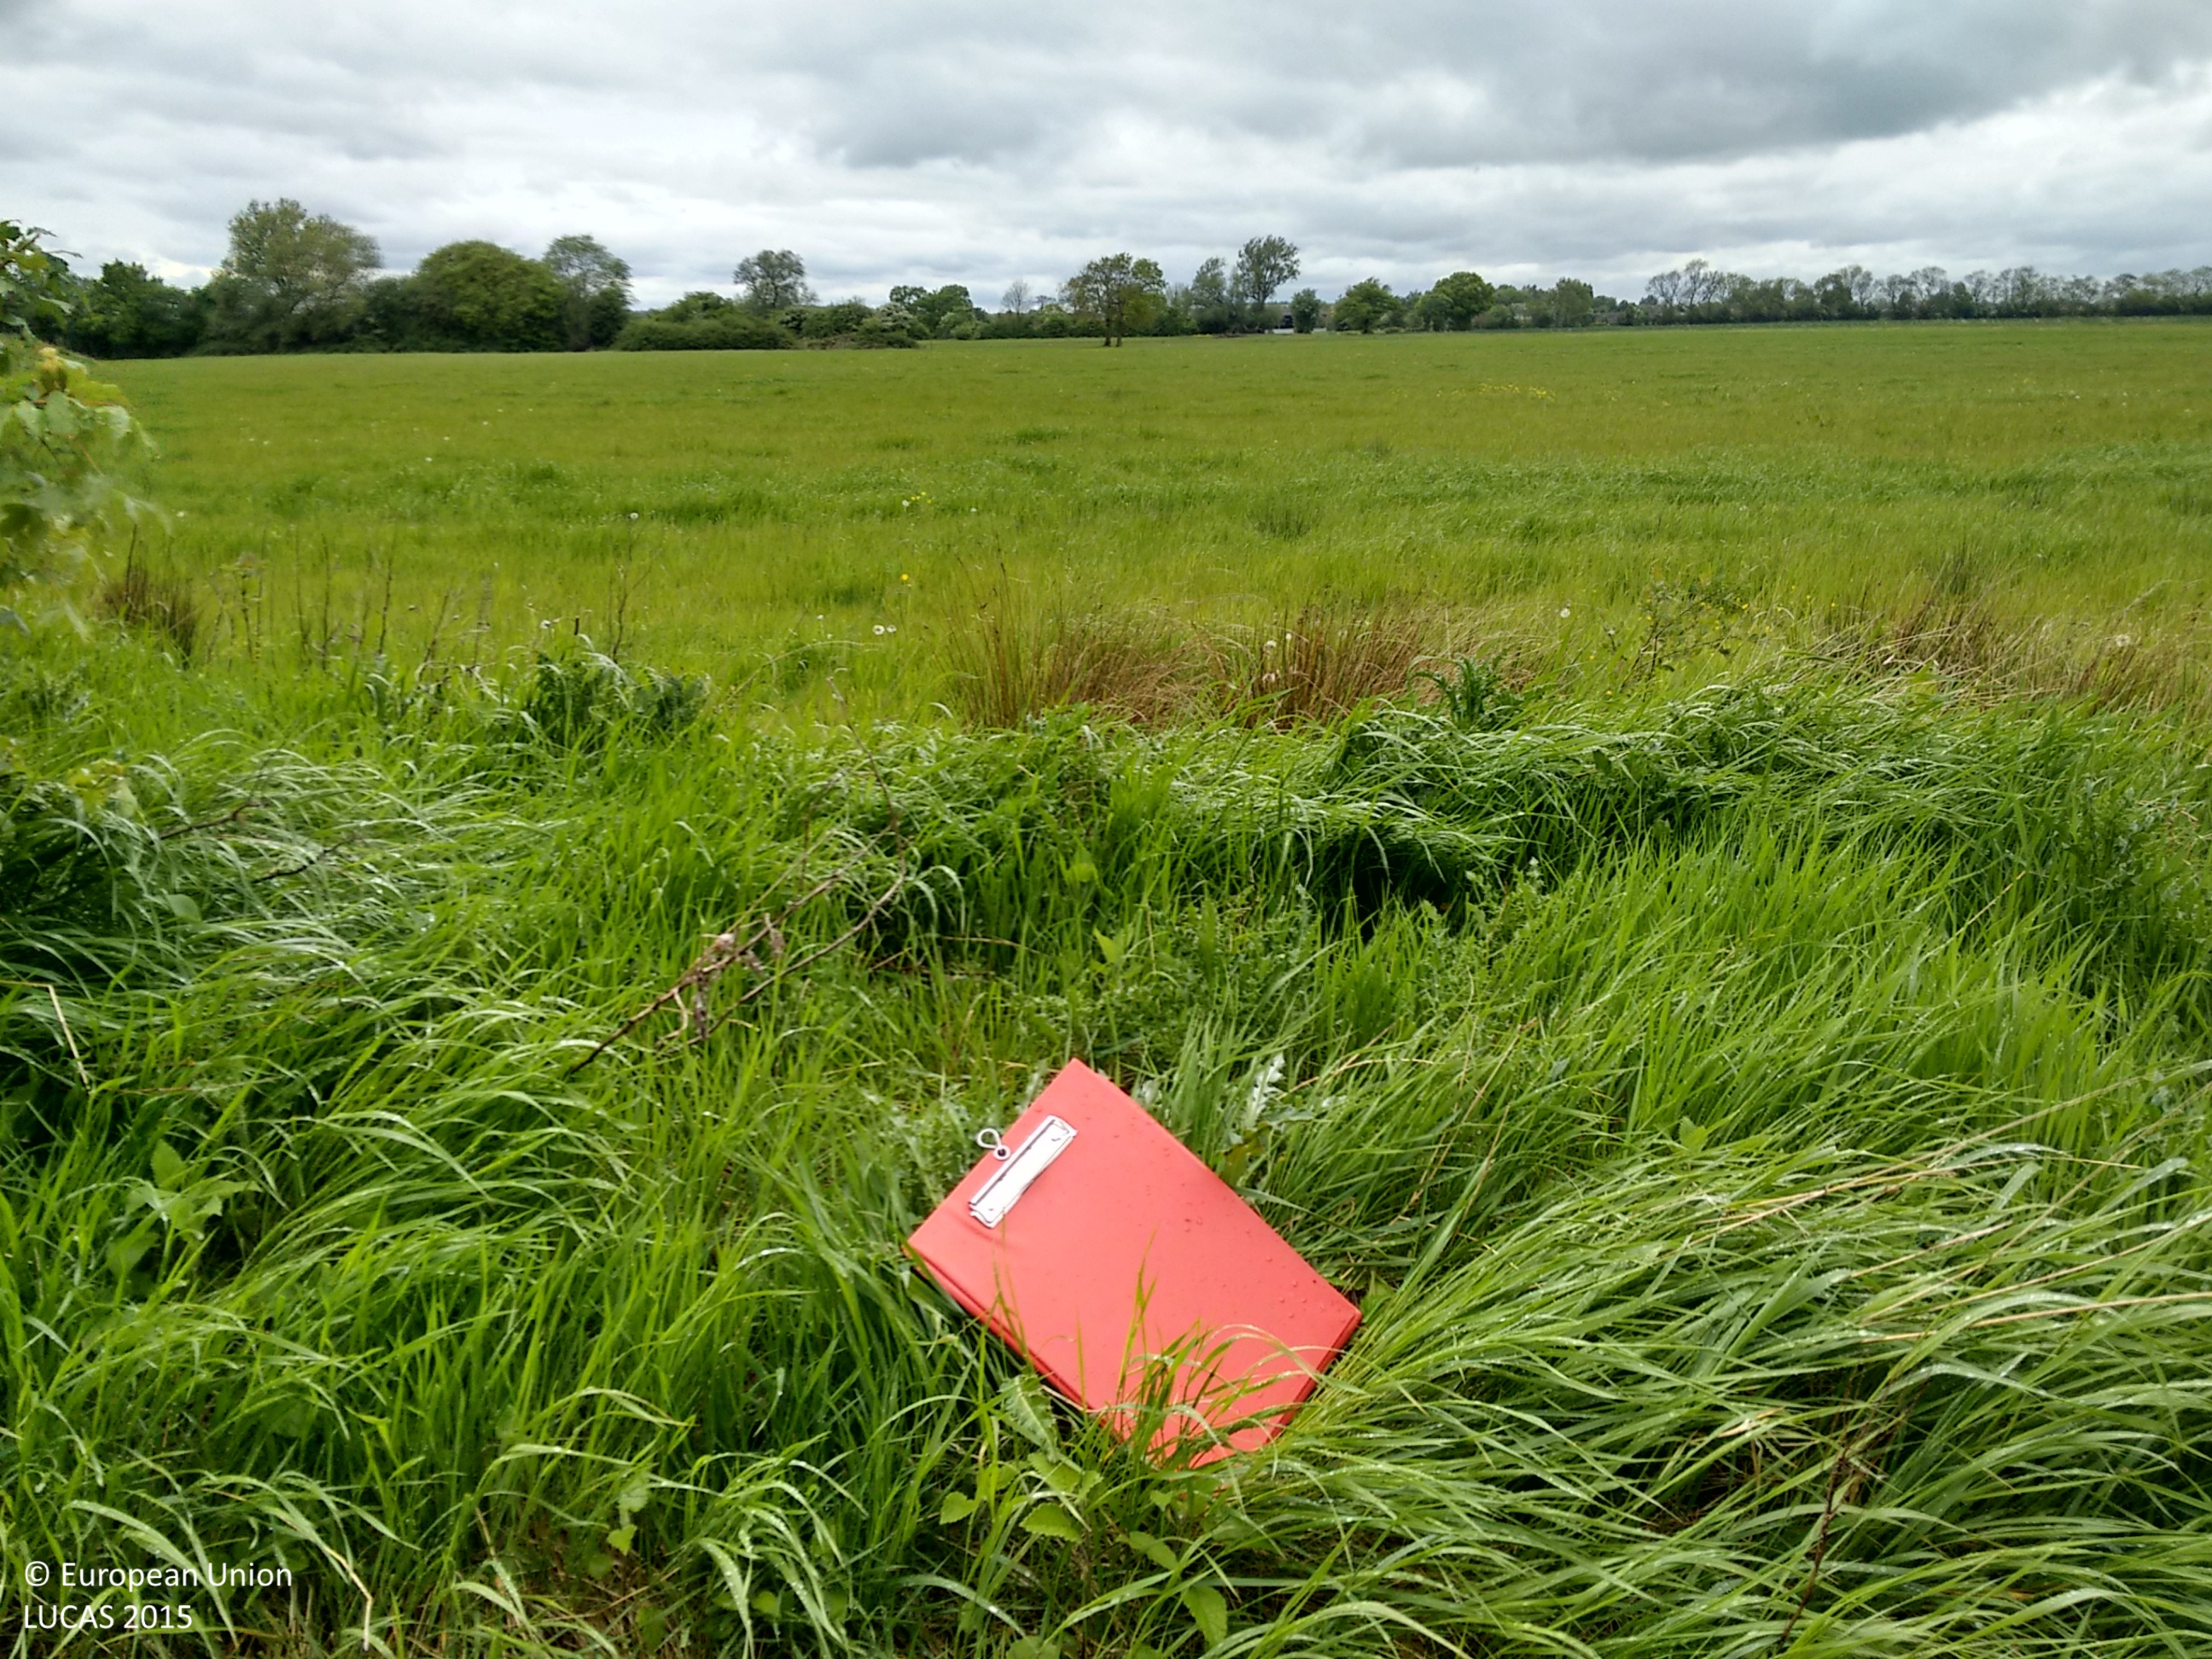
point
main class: Grassland
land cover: Grassland without tree/shrub cover
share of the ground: > 75 %
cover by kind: herbaceous plants 100 %
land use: Agriculture (excluding fallow land and kitchen gardens)
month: May
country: GB
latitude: 53.6138
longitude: -1.1249
